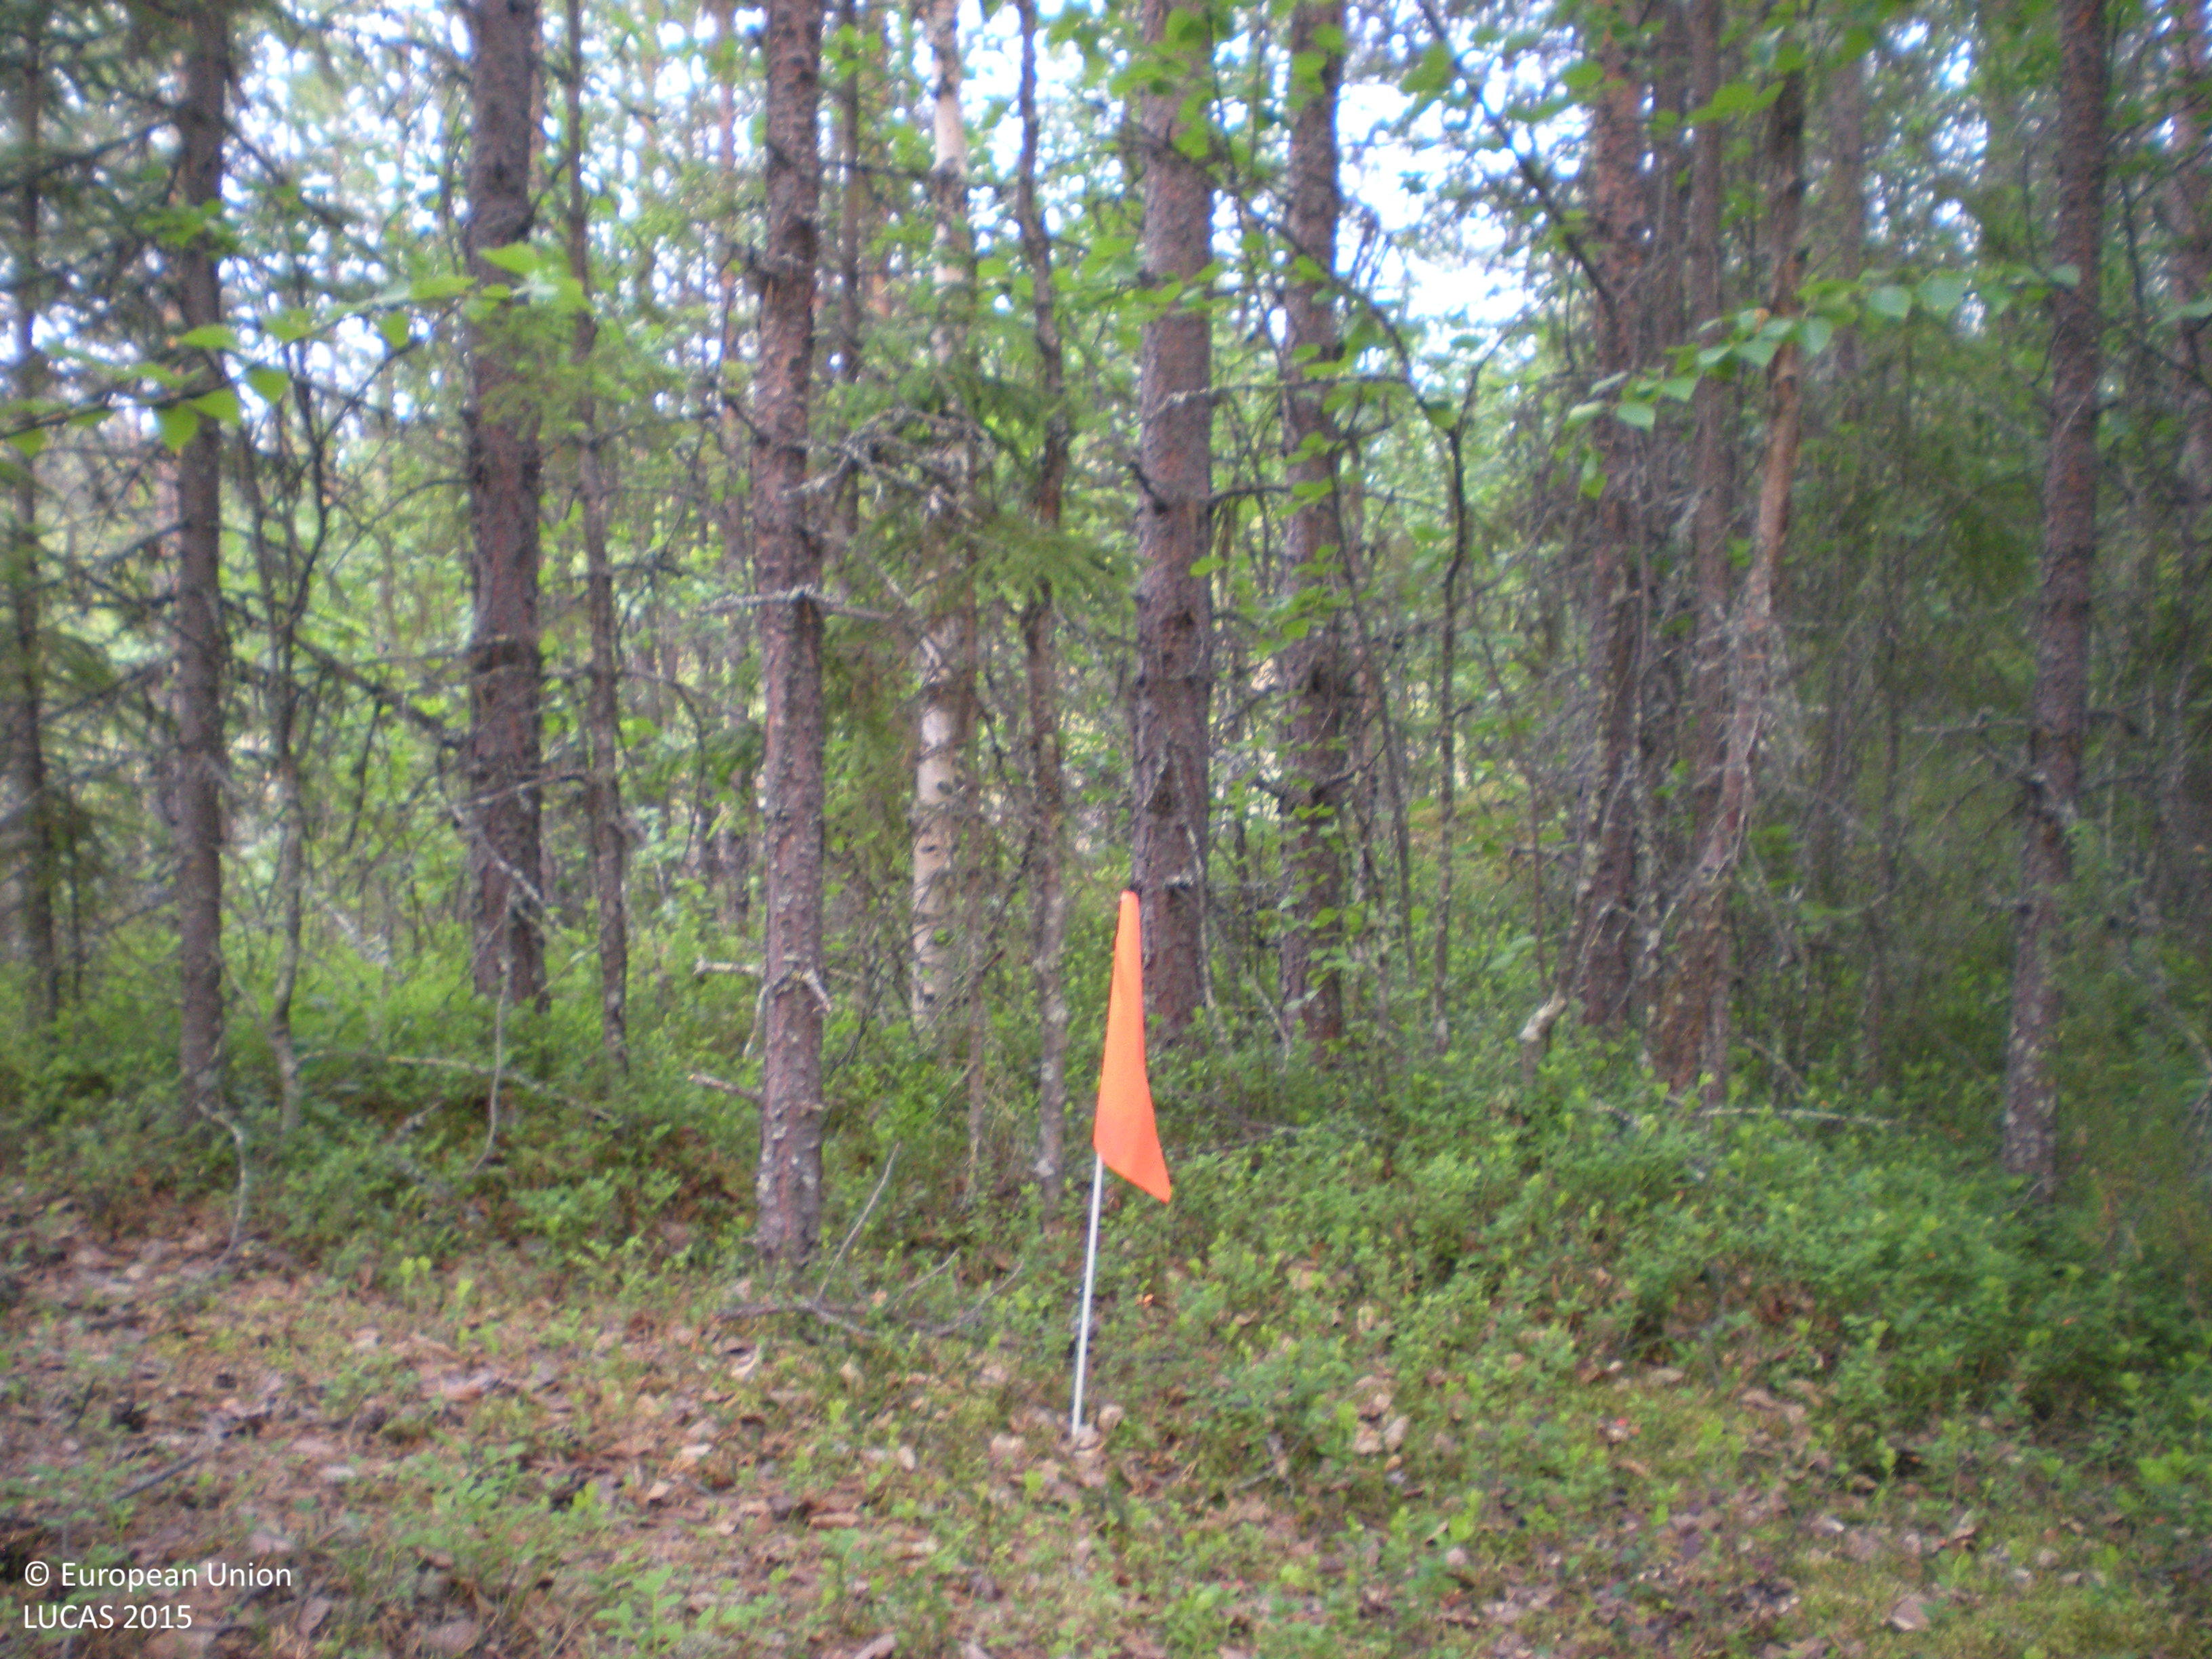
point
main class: Woodland
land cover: Pine dominated mixed woodland
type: boreal forest
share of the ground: 50 - 75 %
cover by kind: coniferous forest trees 55 %, broadleaved forest trees 20 %, shrubs 15 %, lichens and mosses 10 %
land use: Forestry
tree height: > 5 m
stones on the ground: > 50 %
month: July
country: SE
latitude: 65.7300
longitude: 17.0447
